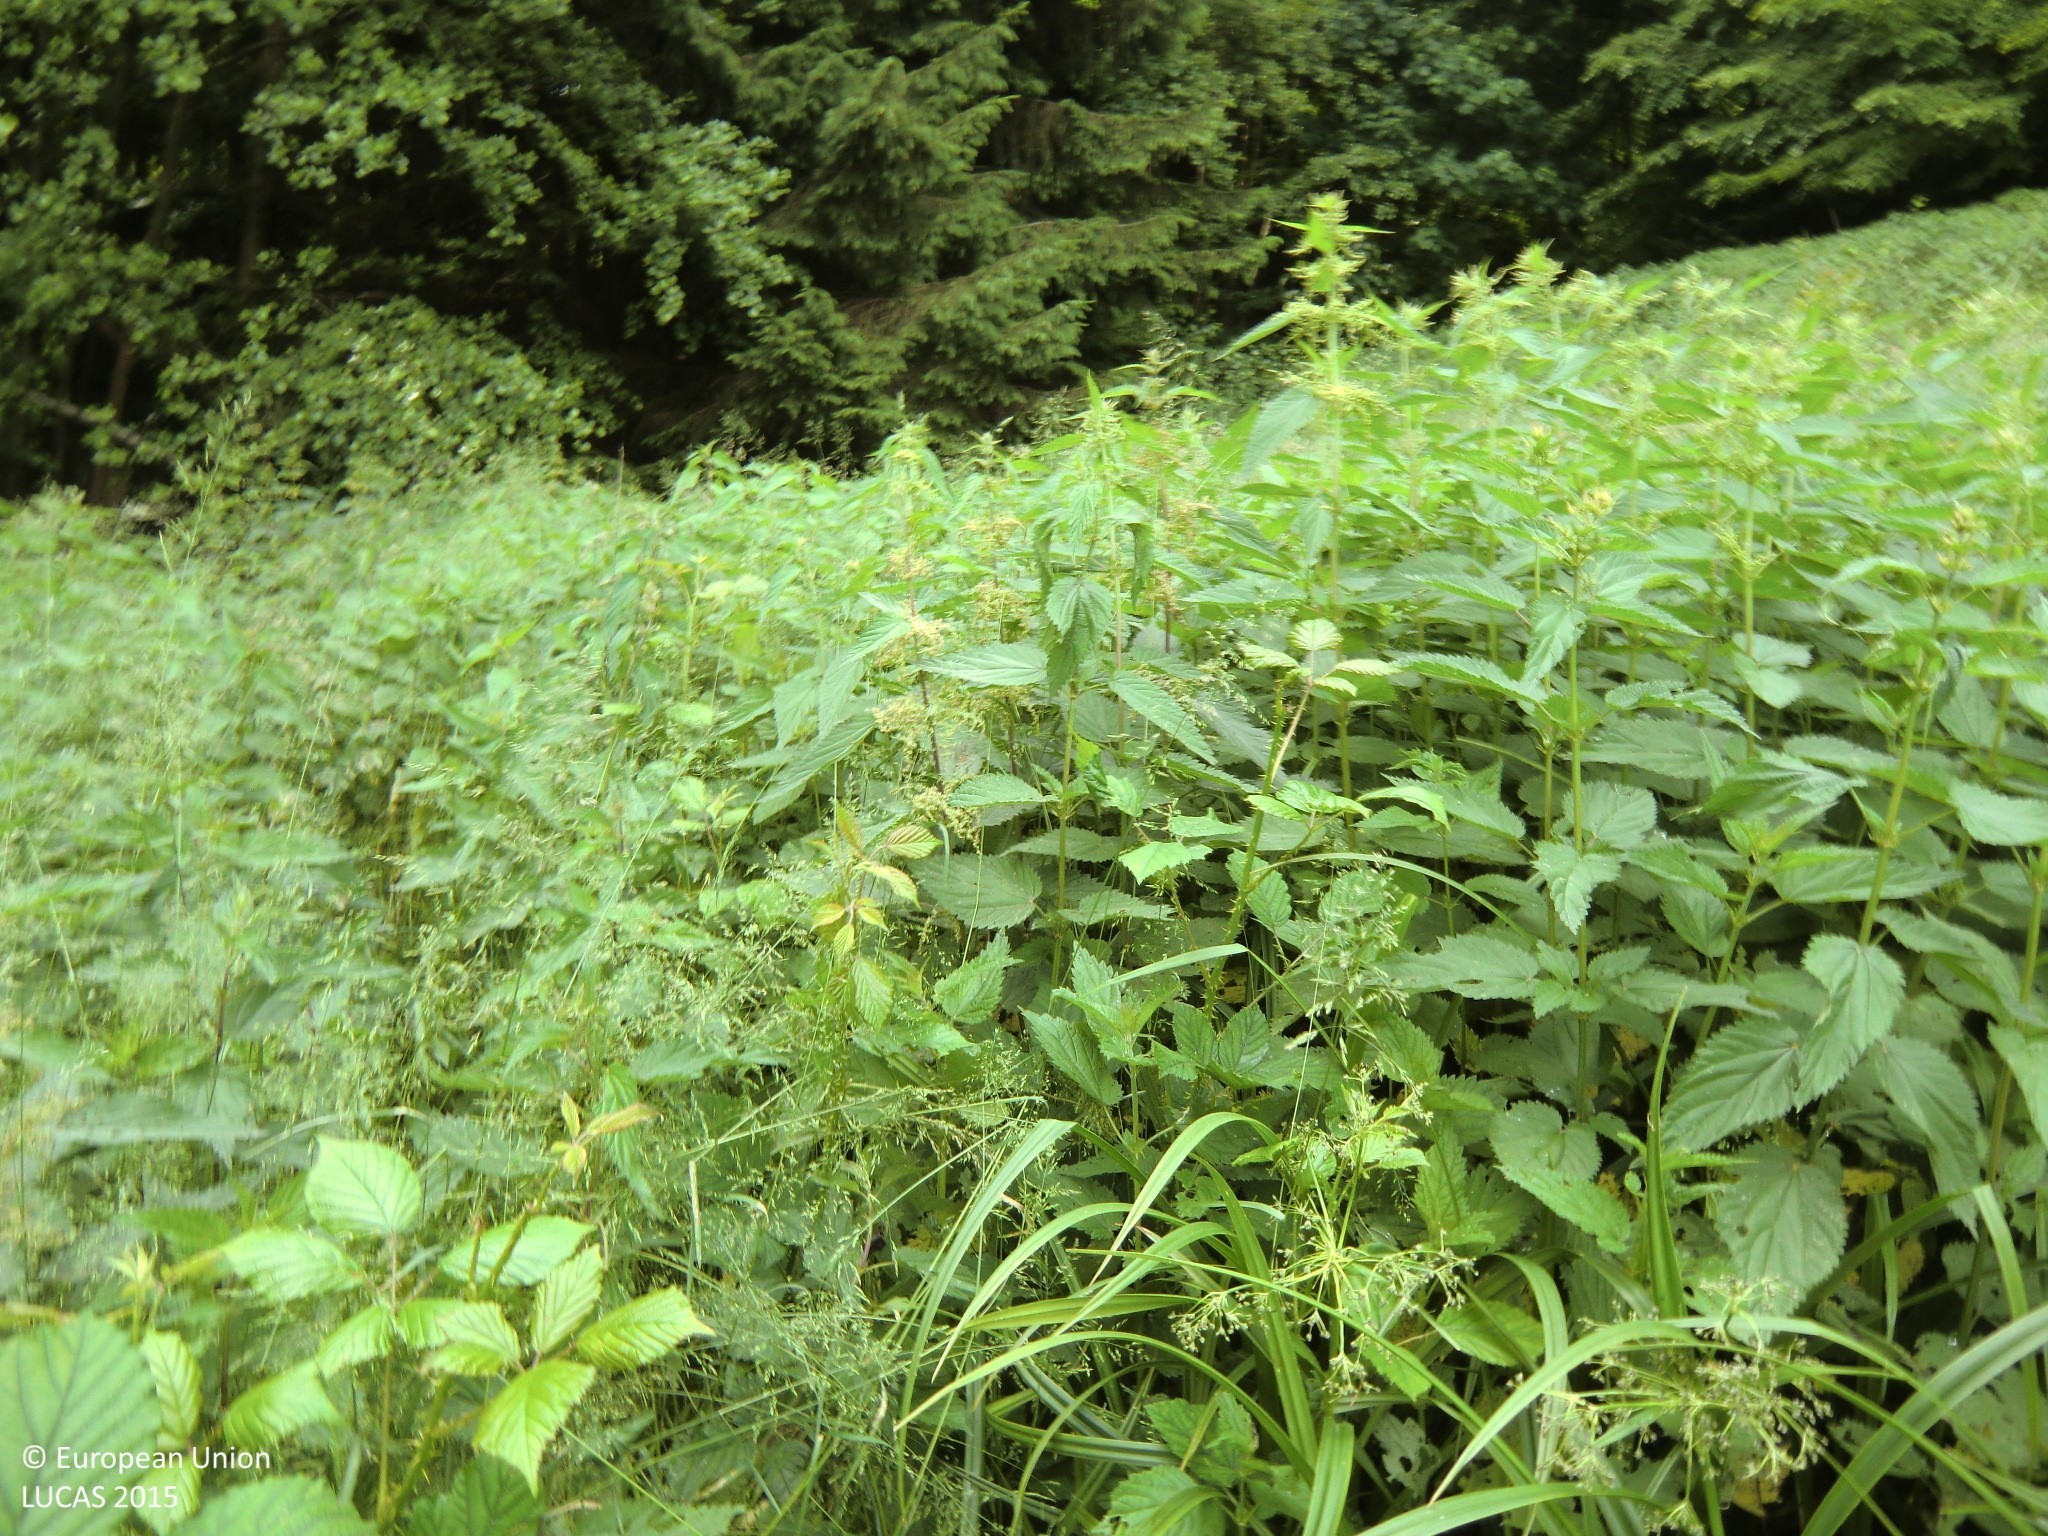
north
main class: Grassland
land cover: Spontaneously vegetated surfaces
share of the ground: > 75 %
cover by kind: herbaceous plants 100 %
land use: Agriculture (excluding fallow land and kitchen gardens)
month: May
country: AT
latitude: 48.1994
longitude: 15.0197
